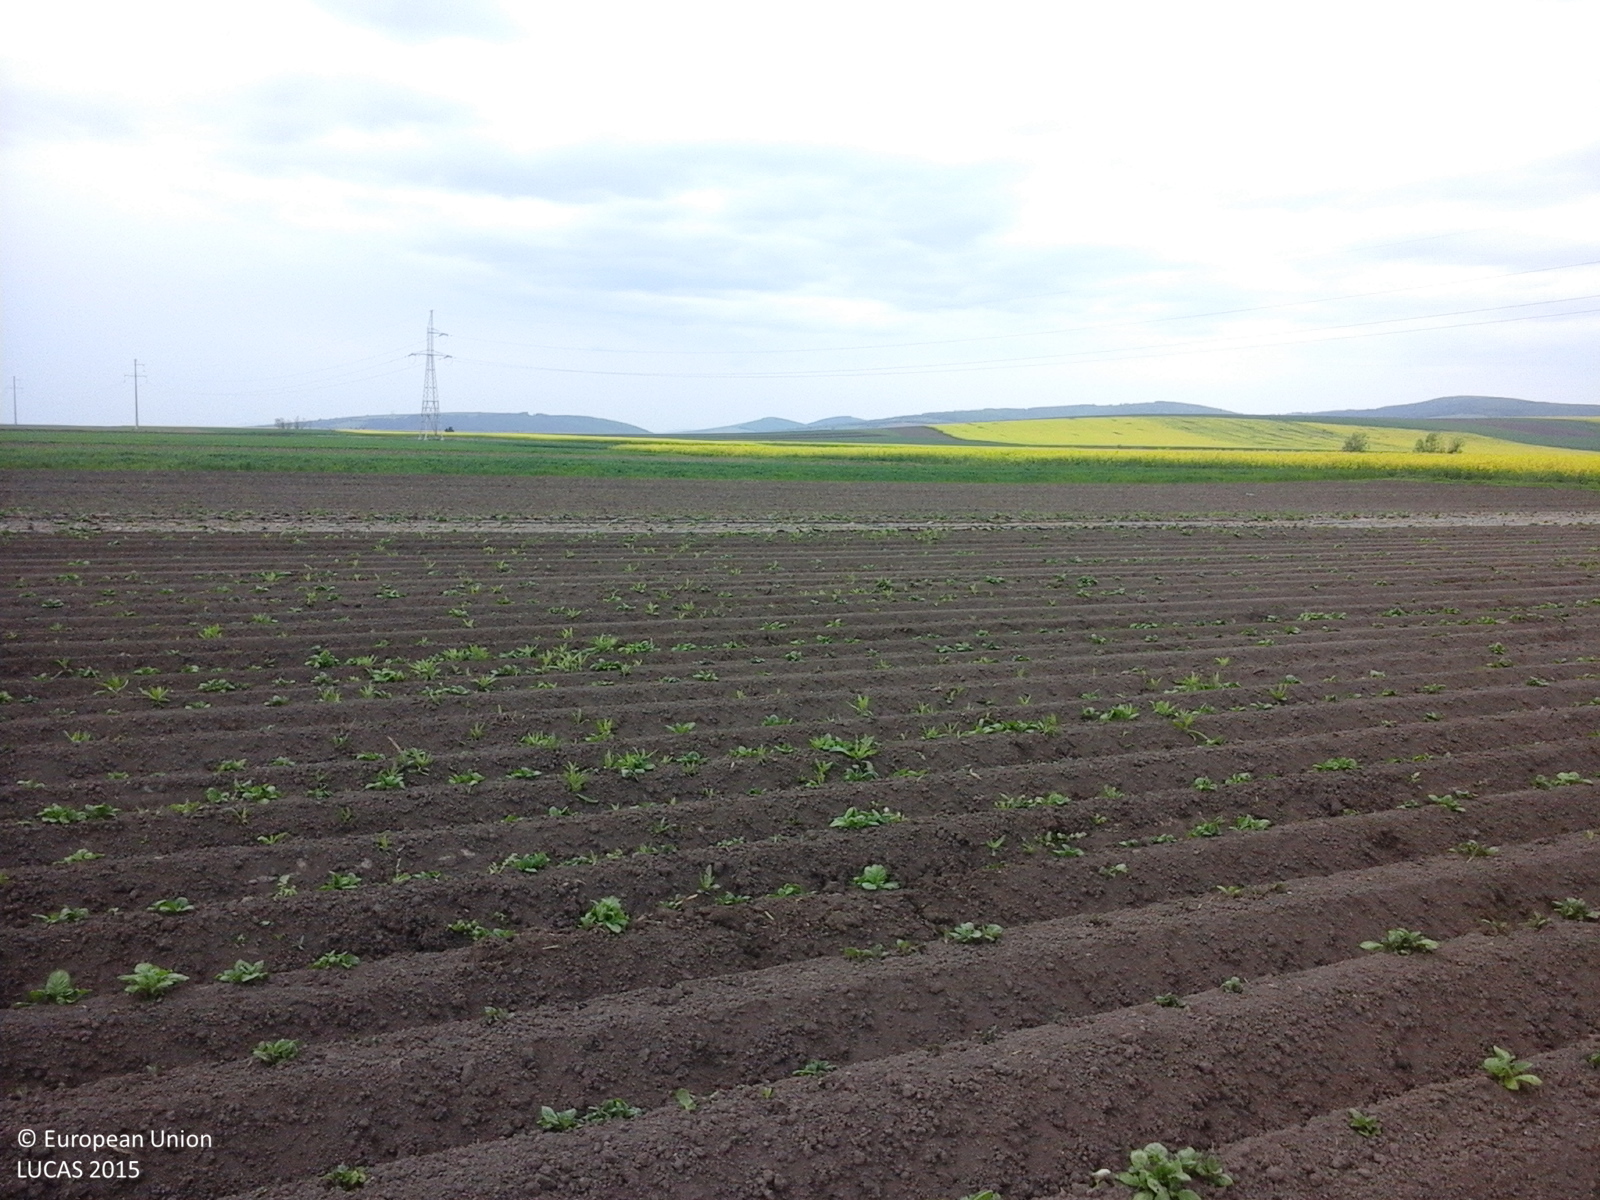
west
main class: Cropland
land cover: Potatoes
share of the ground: < 10 %
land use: Agriculture (excluding fallow land and kitchen gardens)
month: May
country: RO
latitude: 45.8845
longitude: 26.0306
